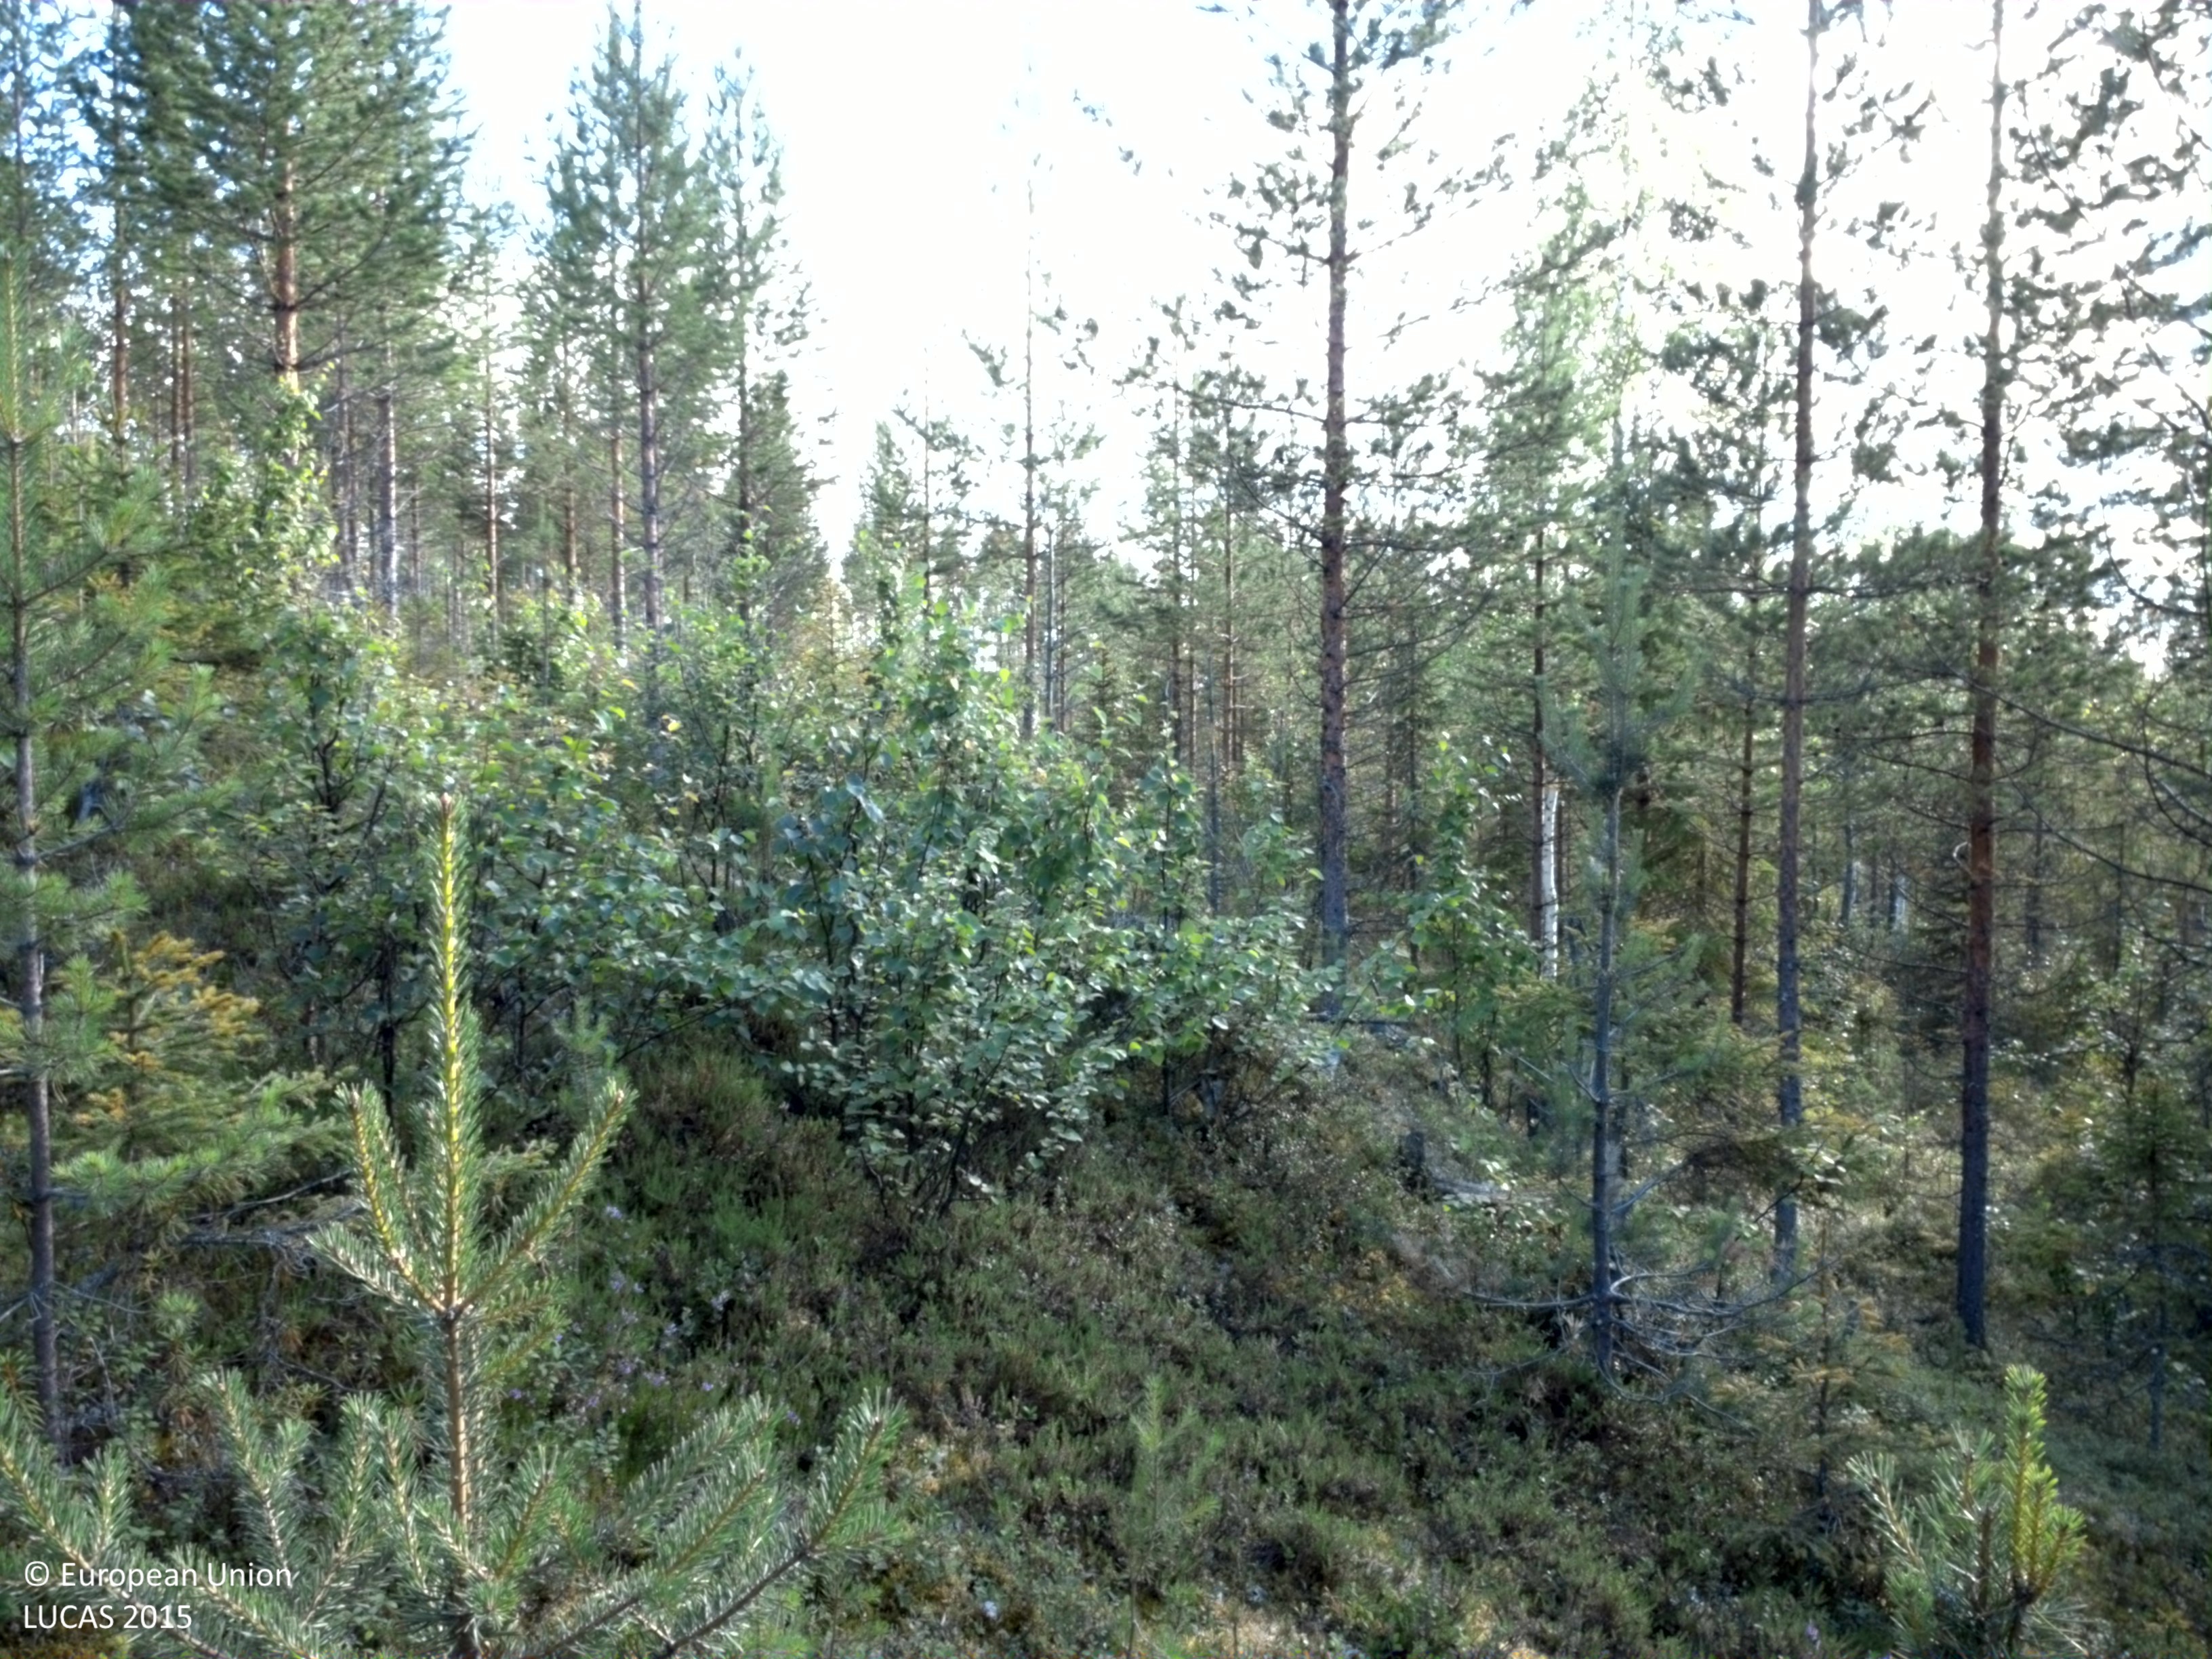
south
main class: Woodland
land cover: Pine dominated coniferous woodland
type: boreal forest
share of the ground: 25 - 50 %
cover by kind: shrubs 60 %, coniferous forest trees 25 %, broadleaved forest trees 5 %, lichens and mosses 5 %, consolidated bare surface 5 %
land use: Forestry
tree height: > 5 m
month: August
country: SE
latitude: 66.4097
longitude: 20.7295
